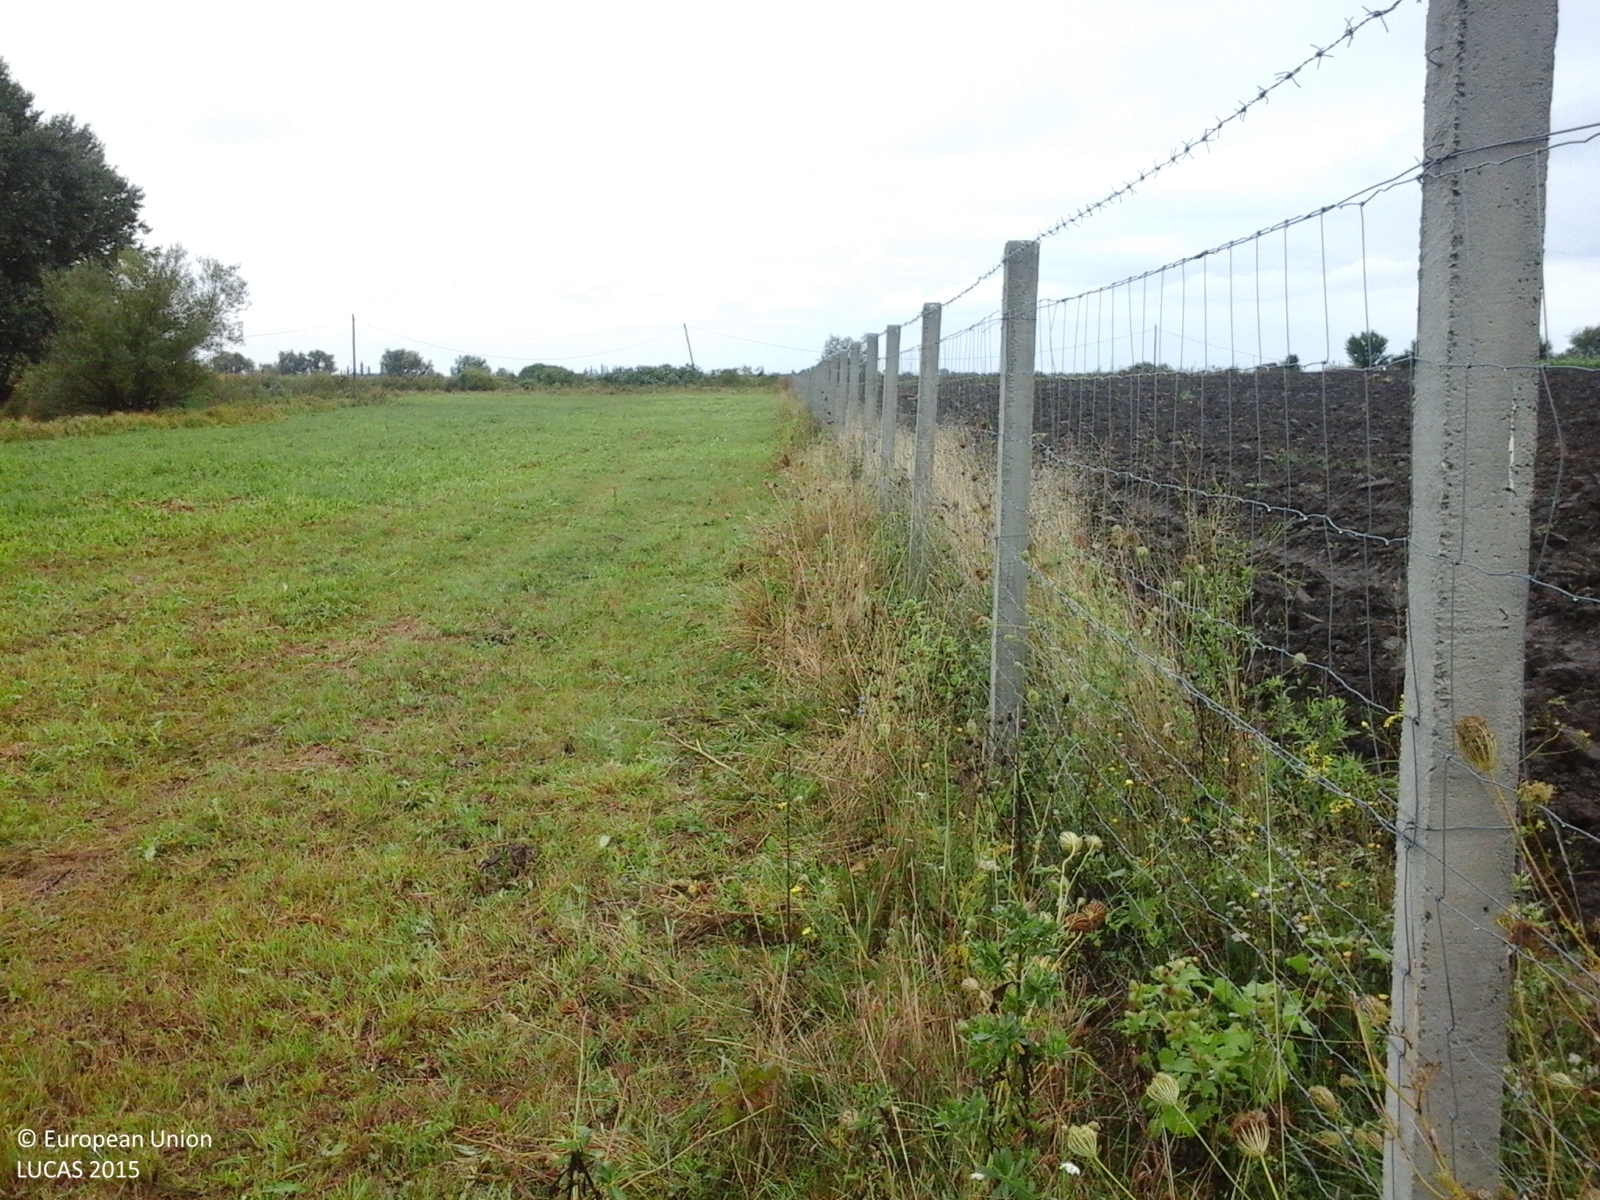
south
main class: Cropland
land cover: Maize
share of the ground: < 10 %
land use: Agriculture (excluding fallow land and kitchen gardens)
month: September
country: RO
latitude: 46.8609
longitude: 21.6237
